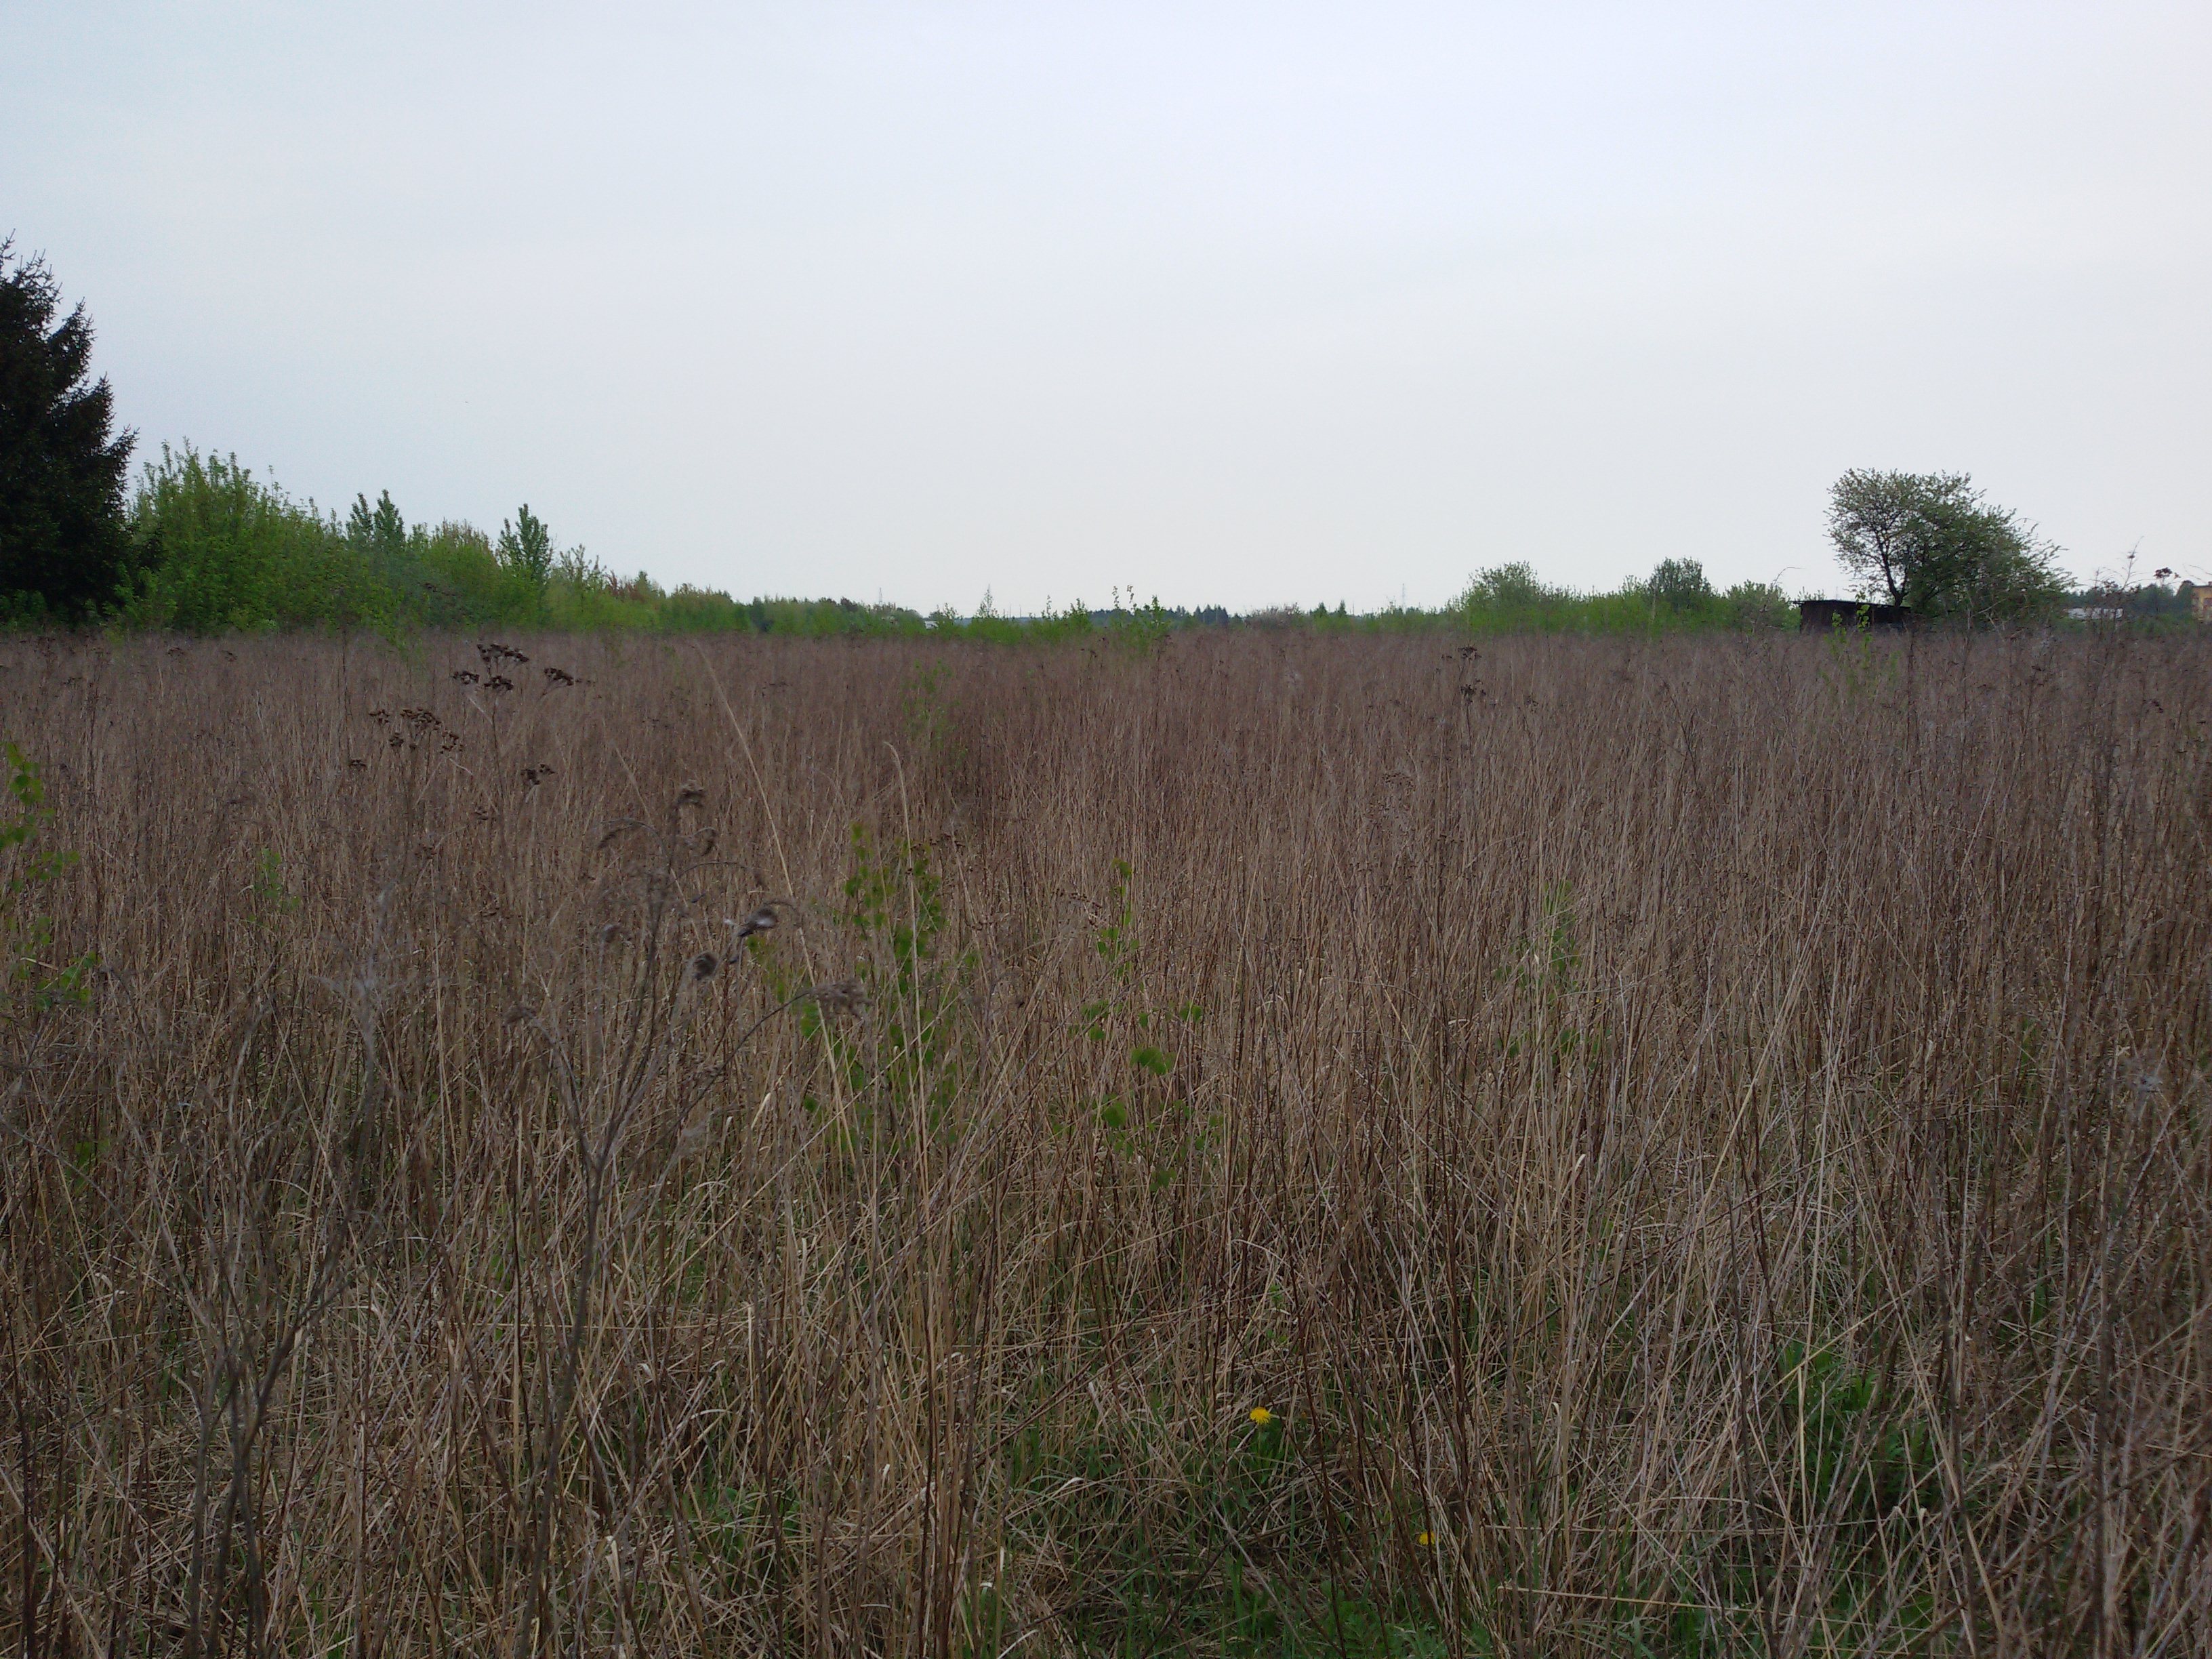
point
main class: Grassland
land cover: Spontaneously vegetated surfaces
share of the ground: > 75 %
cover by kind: herbaceous plants 100 %
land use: Fallow land
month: May
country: PL
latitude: 52.0454
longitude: 23.1271
